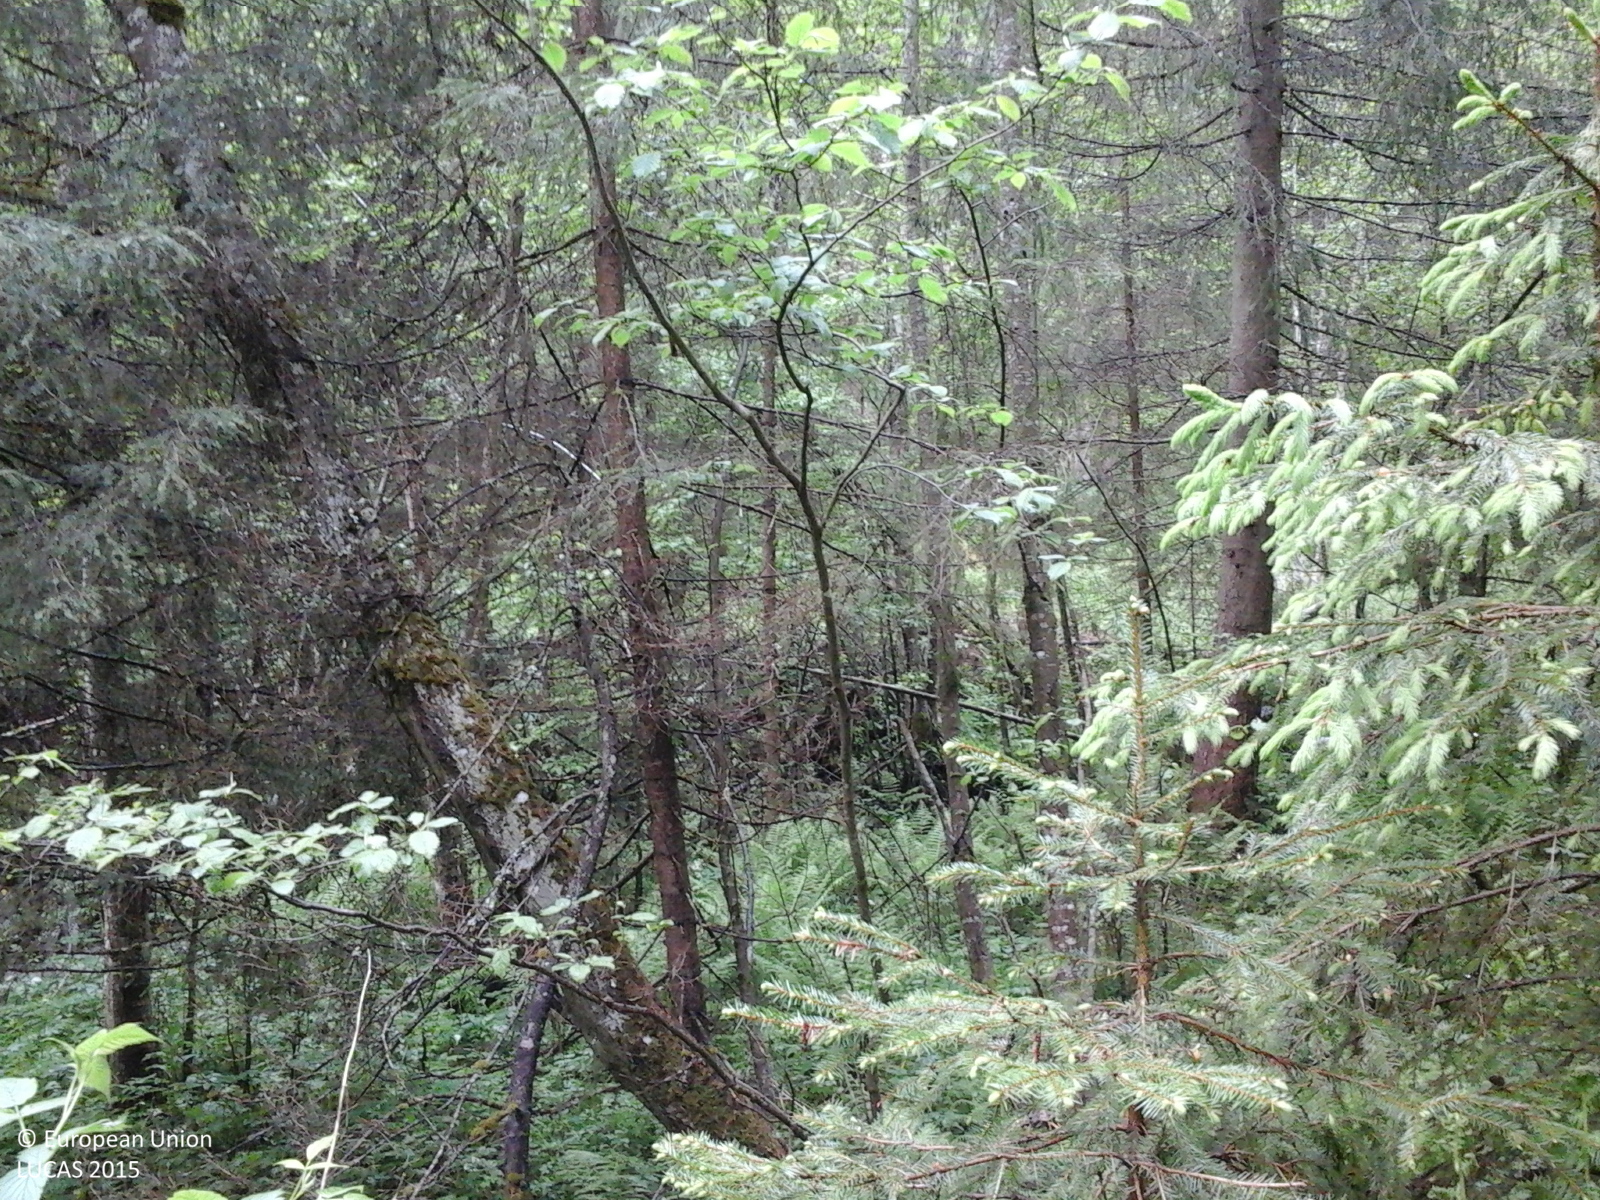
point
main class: Woodland
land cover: Spruce dominated coniferous woodland
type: alpine coniferous forest
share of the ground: > 75 %
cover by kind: coniferous forest trees 100 %
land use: Forestry
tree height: > 5 m
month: June
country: RO
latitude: 47.1118
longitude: 25.5466
